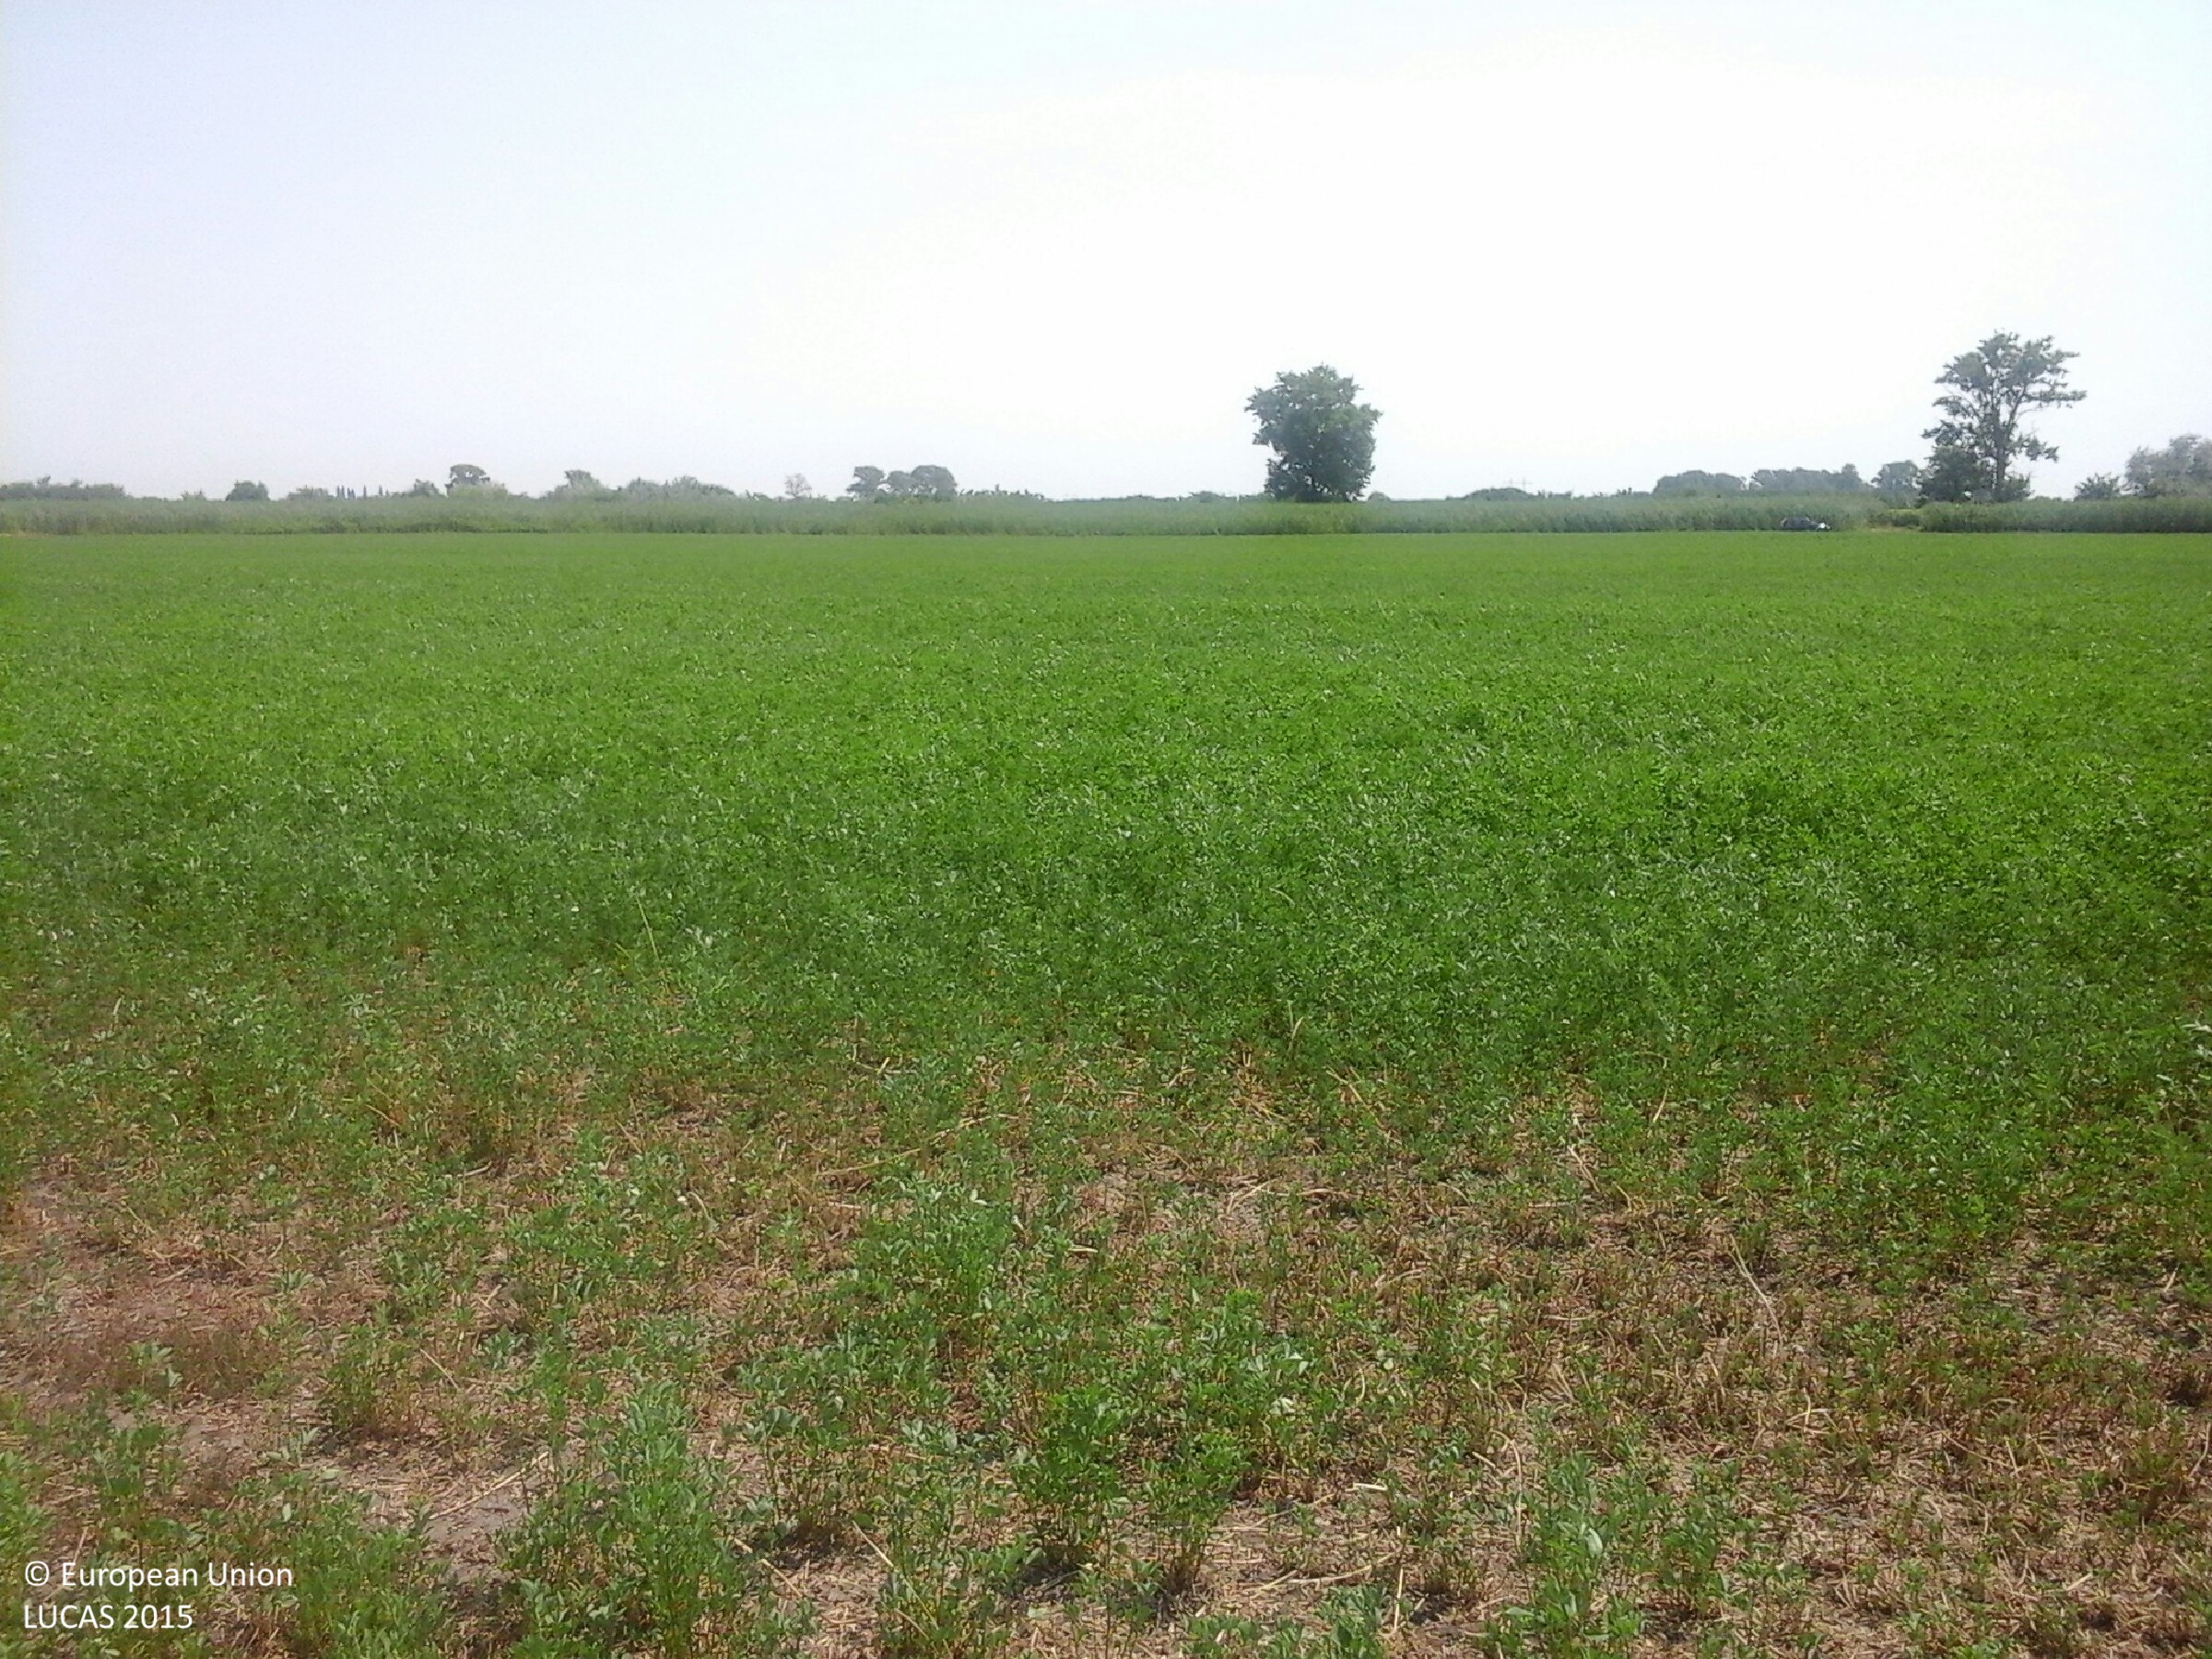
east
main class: Cropland
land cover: Lucerne
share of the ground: 50 - 75 %
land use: Agriculture (excluding fallow land and kitchen gardens)
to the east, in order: Lucerne; Spontaneously vegetated surfaces; Inland fresh running water; Spontaneously vegetated surfaces
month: July
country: HU
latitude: 47.7413
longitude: 20.4741
